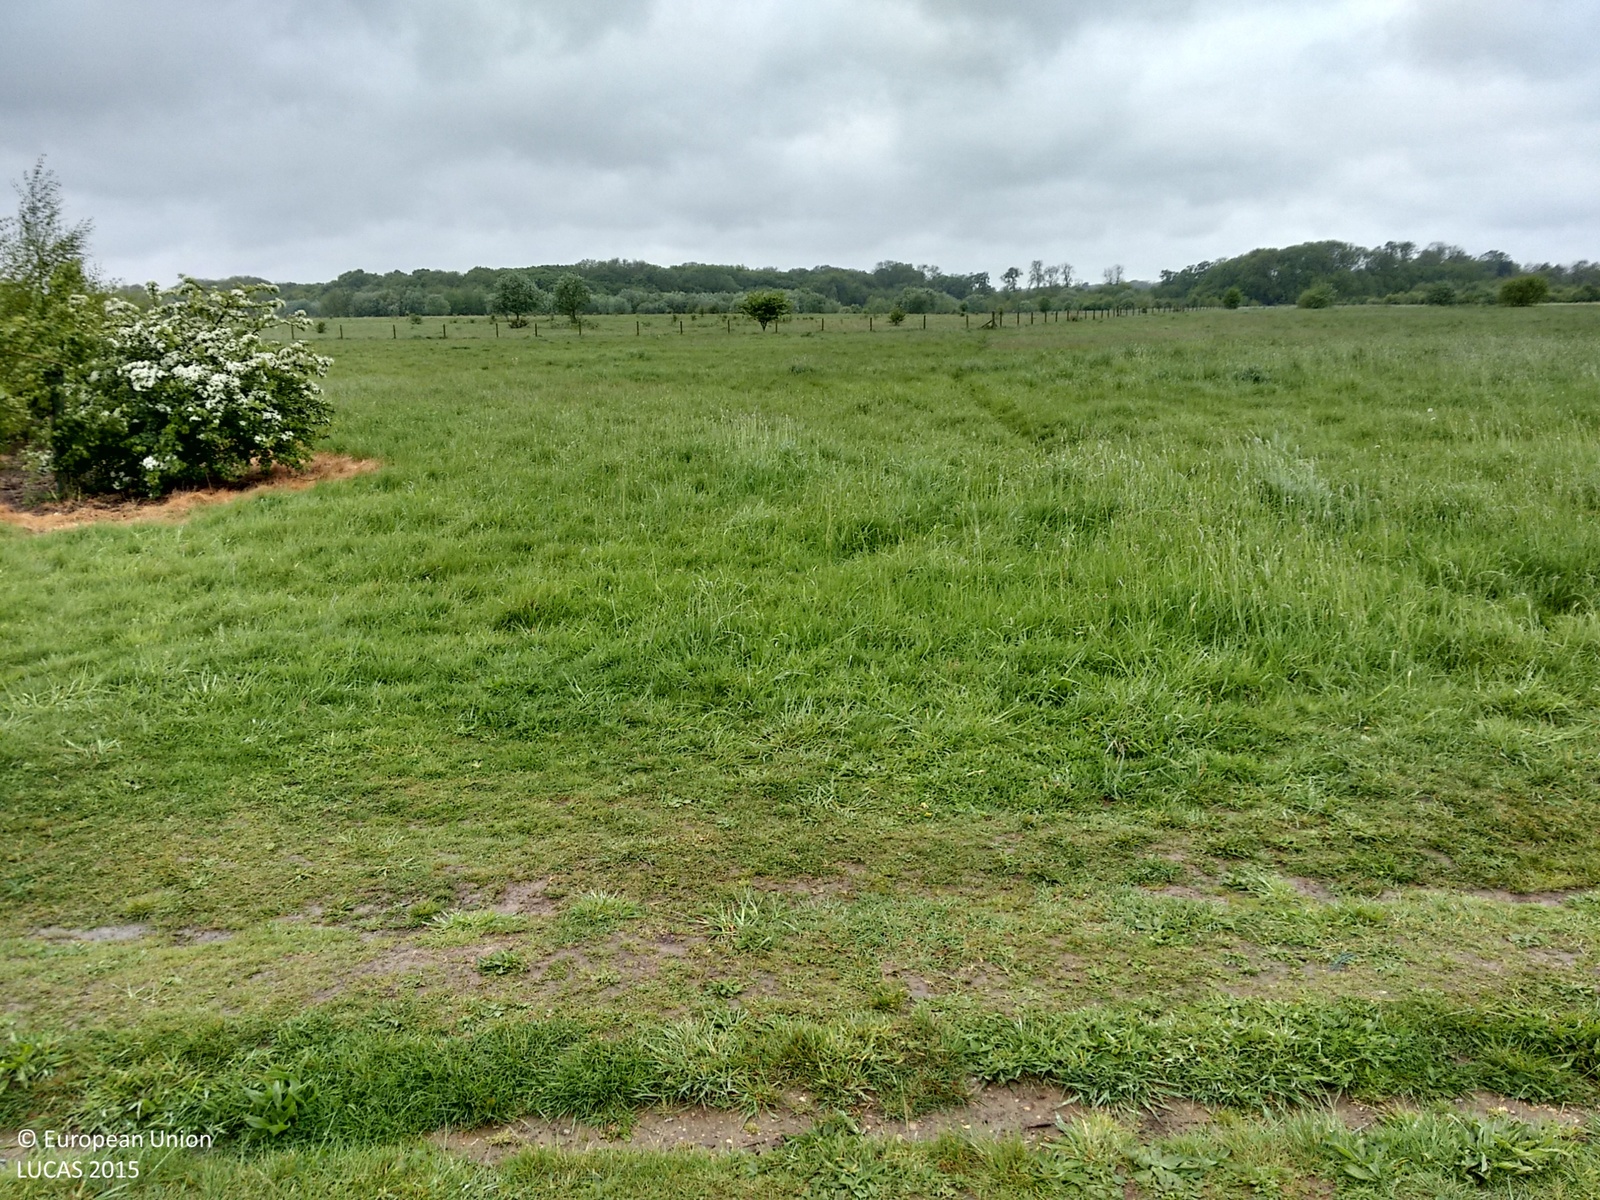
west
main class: Woodland
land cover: Broadleaved woodland
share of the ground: > 75 %
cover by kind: broadleaved forest trees 90 %, herbaceous plants 10 %
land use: Semi-natural and natural areas not in use
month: May
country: GB
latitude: 51.7693
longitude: -0.2519
